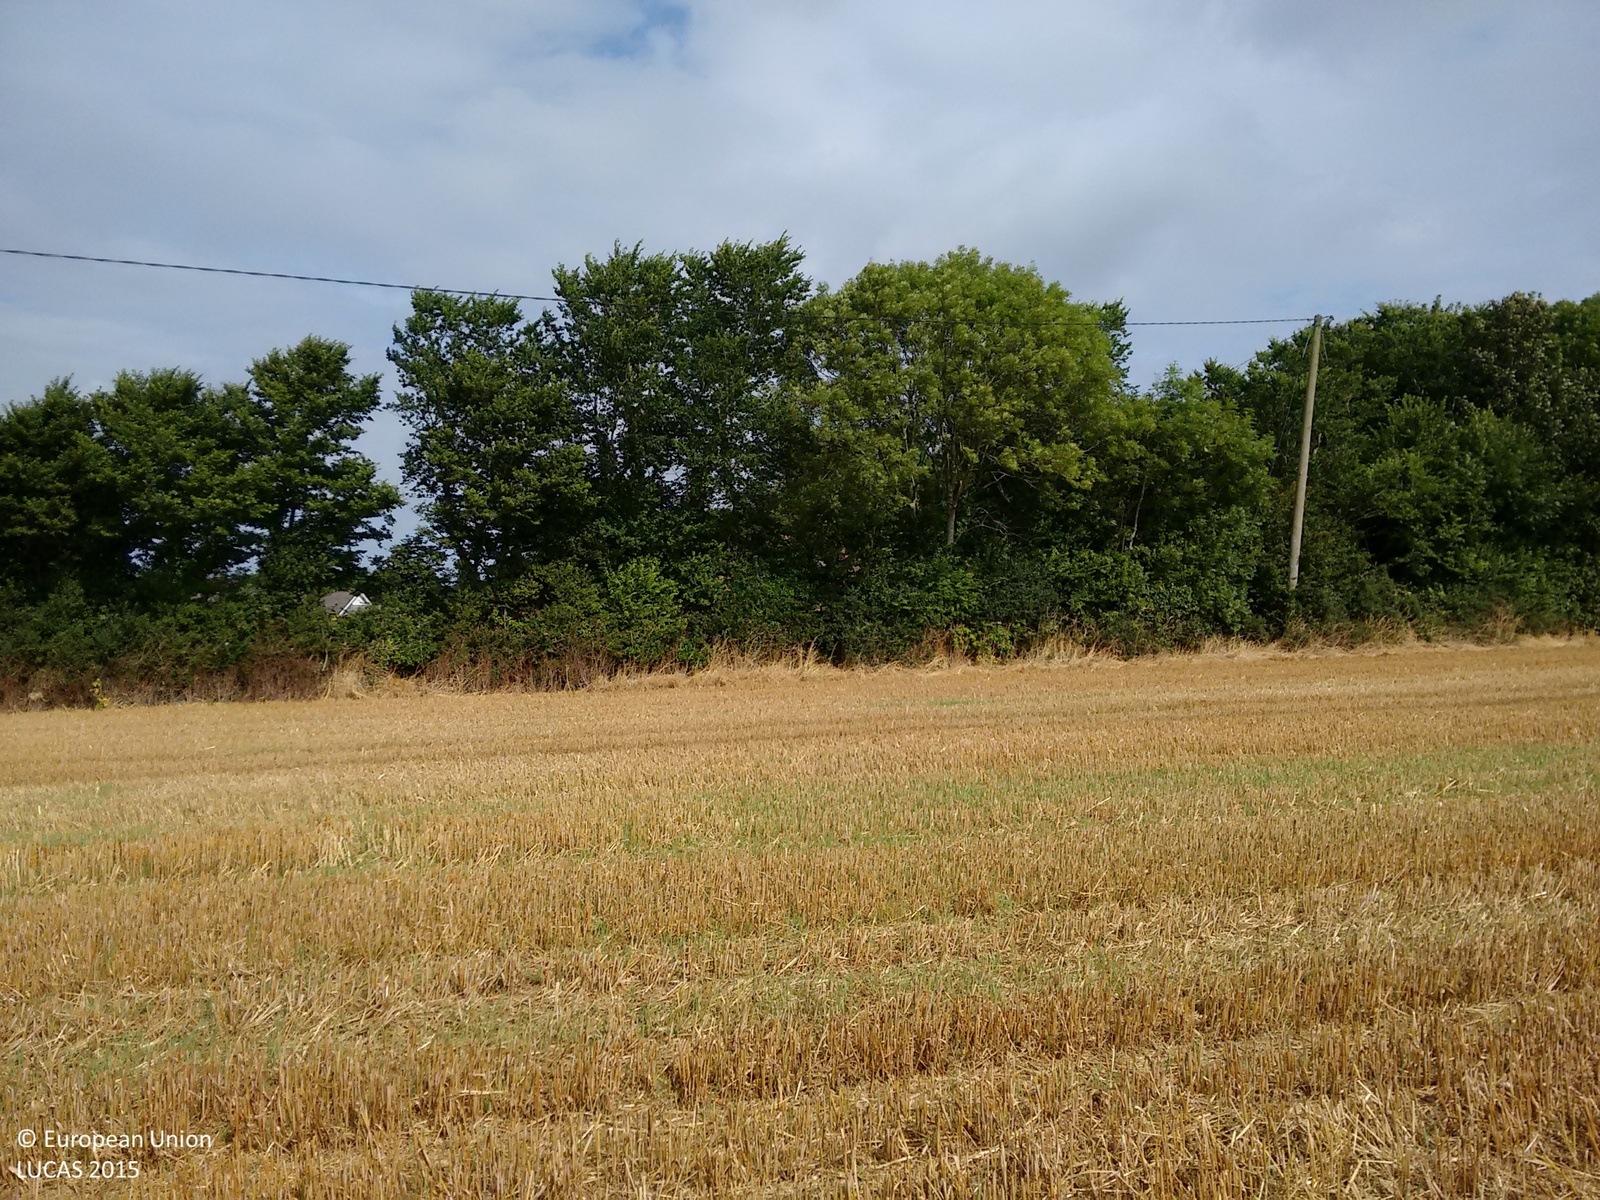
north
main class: Cropland
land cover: Oats
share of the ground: > 75 %
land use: Agriculture (excluding fallow land and kitchen gardens)
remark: Harvested field
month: August
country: IE
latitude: 52.3641
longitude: -6.5325
